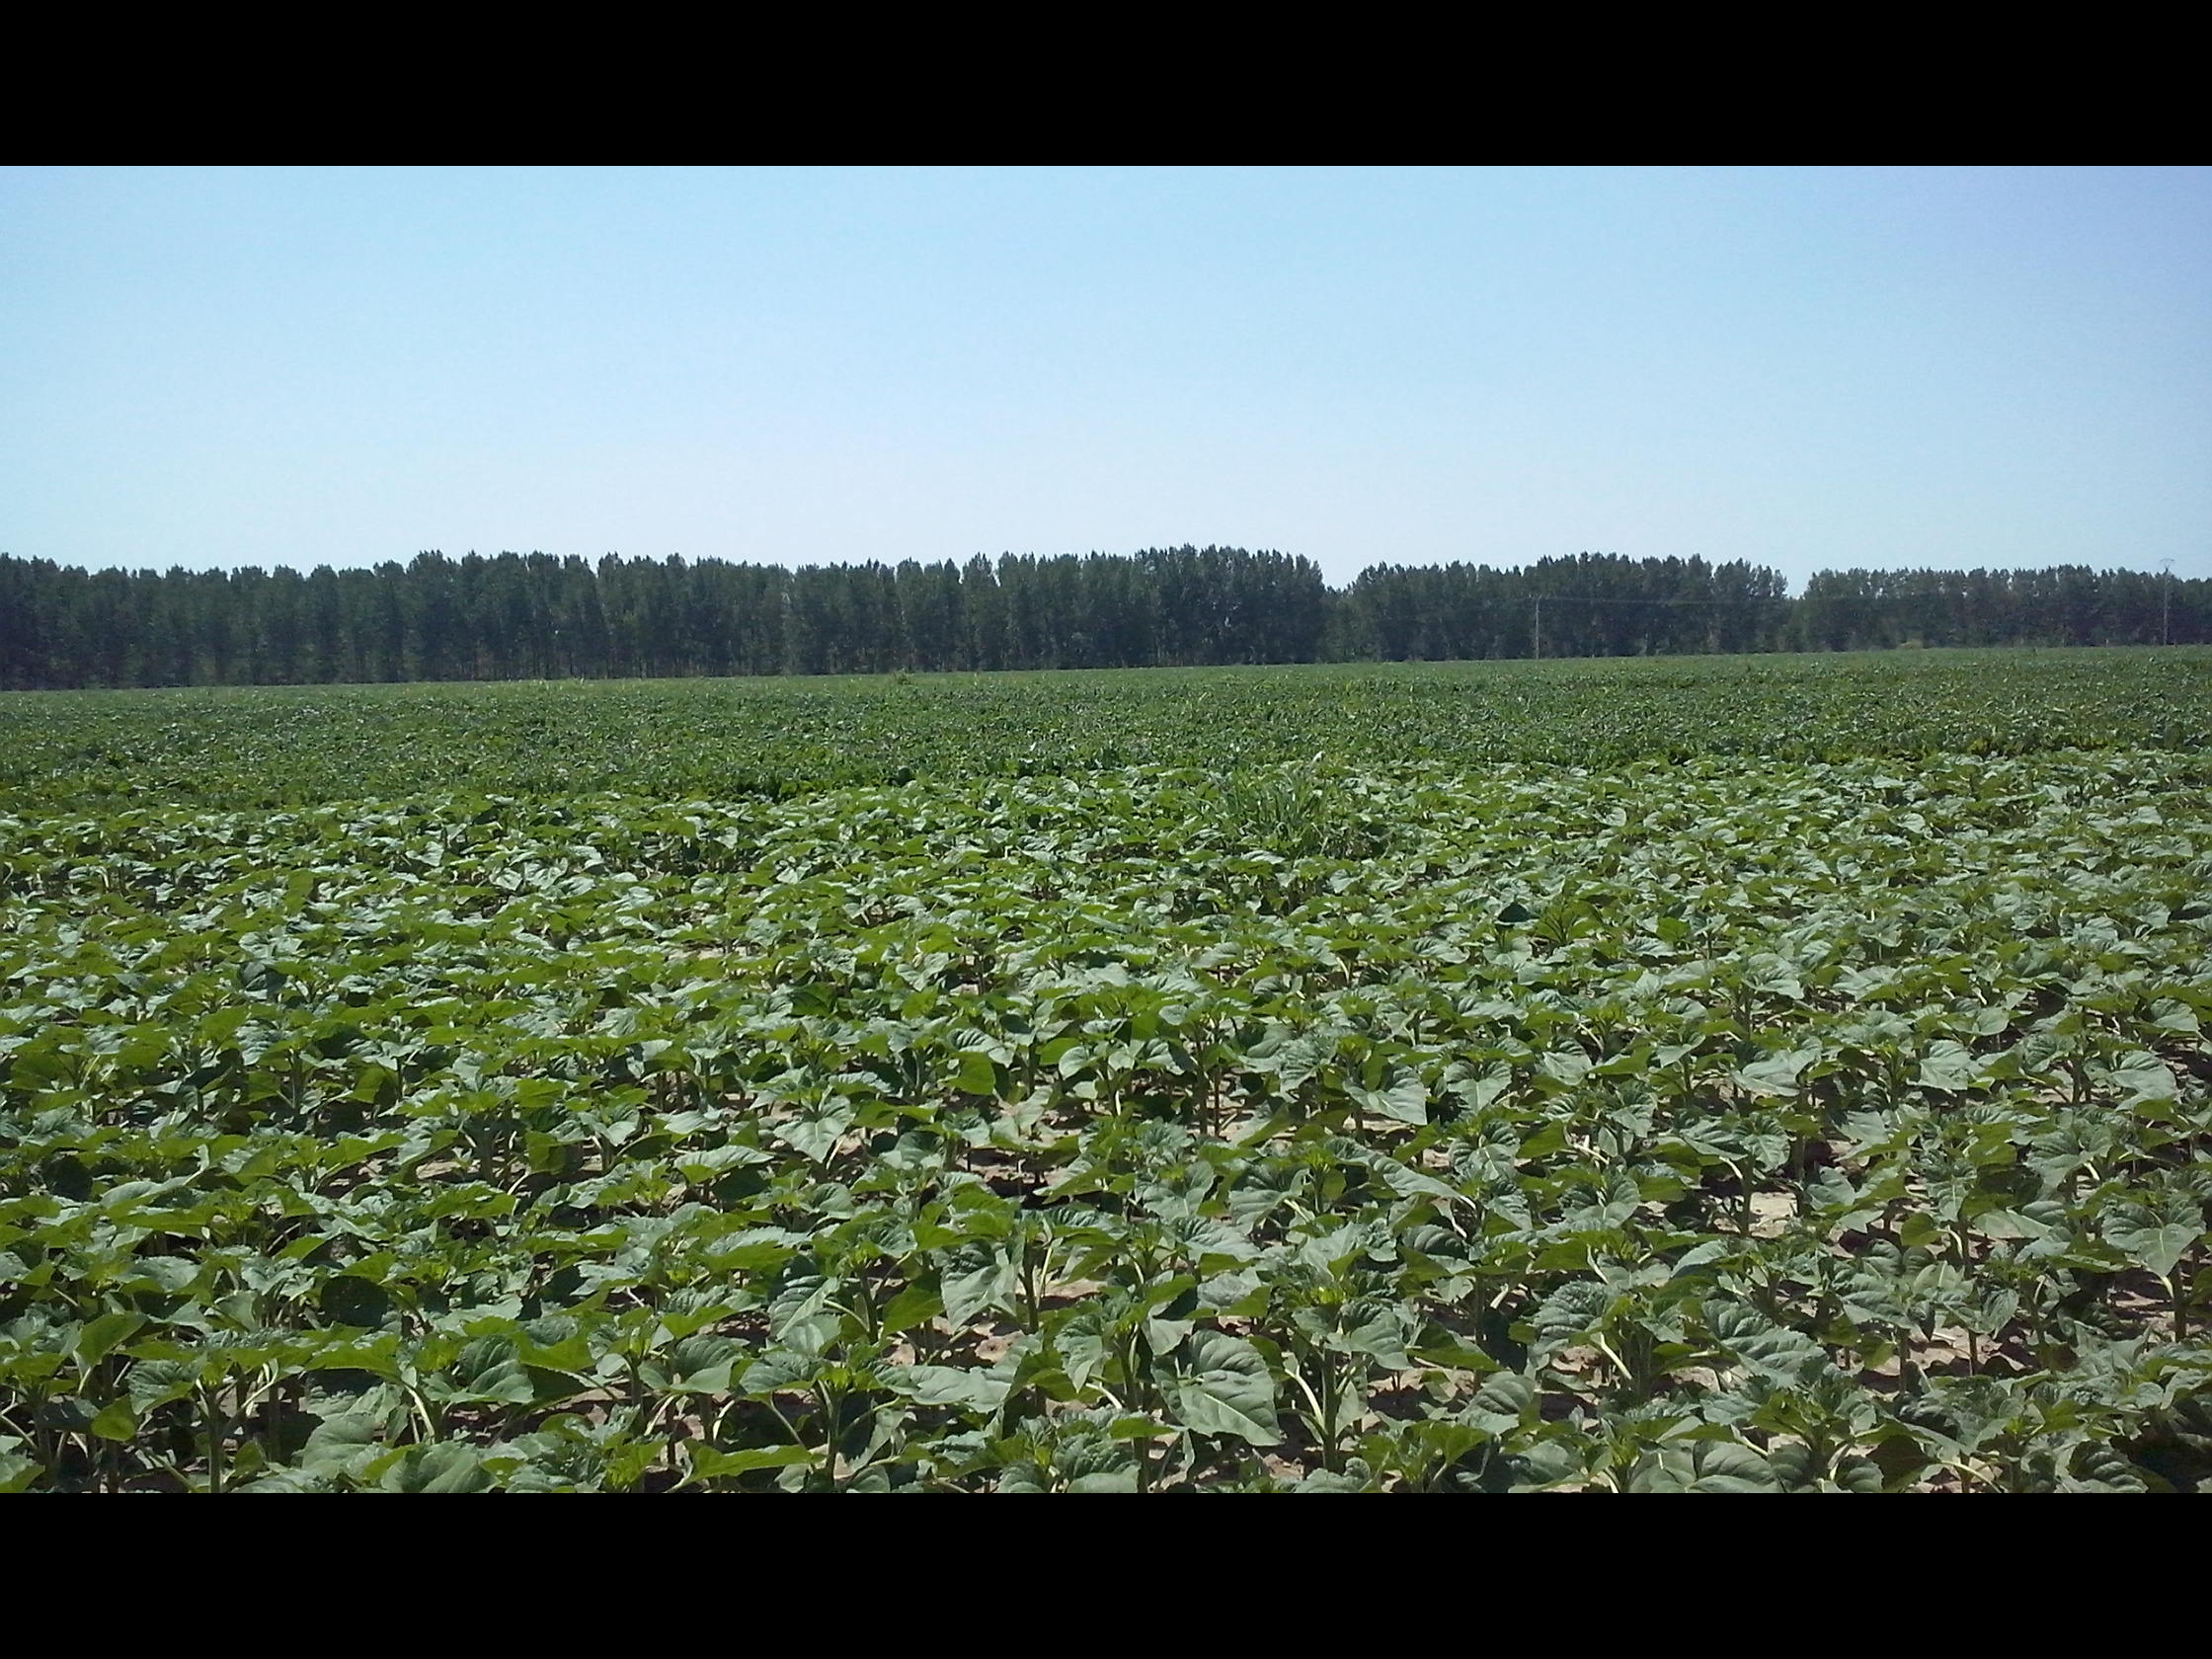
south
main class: Cropland
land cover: Sunflower
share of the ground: > 75 %
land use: Agriculture (excluding fallow land and kitchen gardens)
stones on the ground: < 10 %
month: June
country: ES
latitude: 41.4809
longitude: -5.0791
